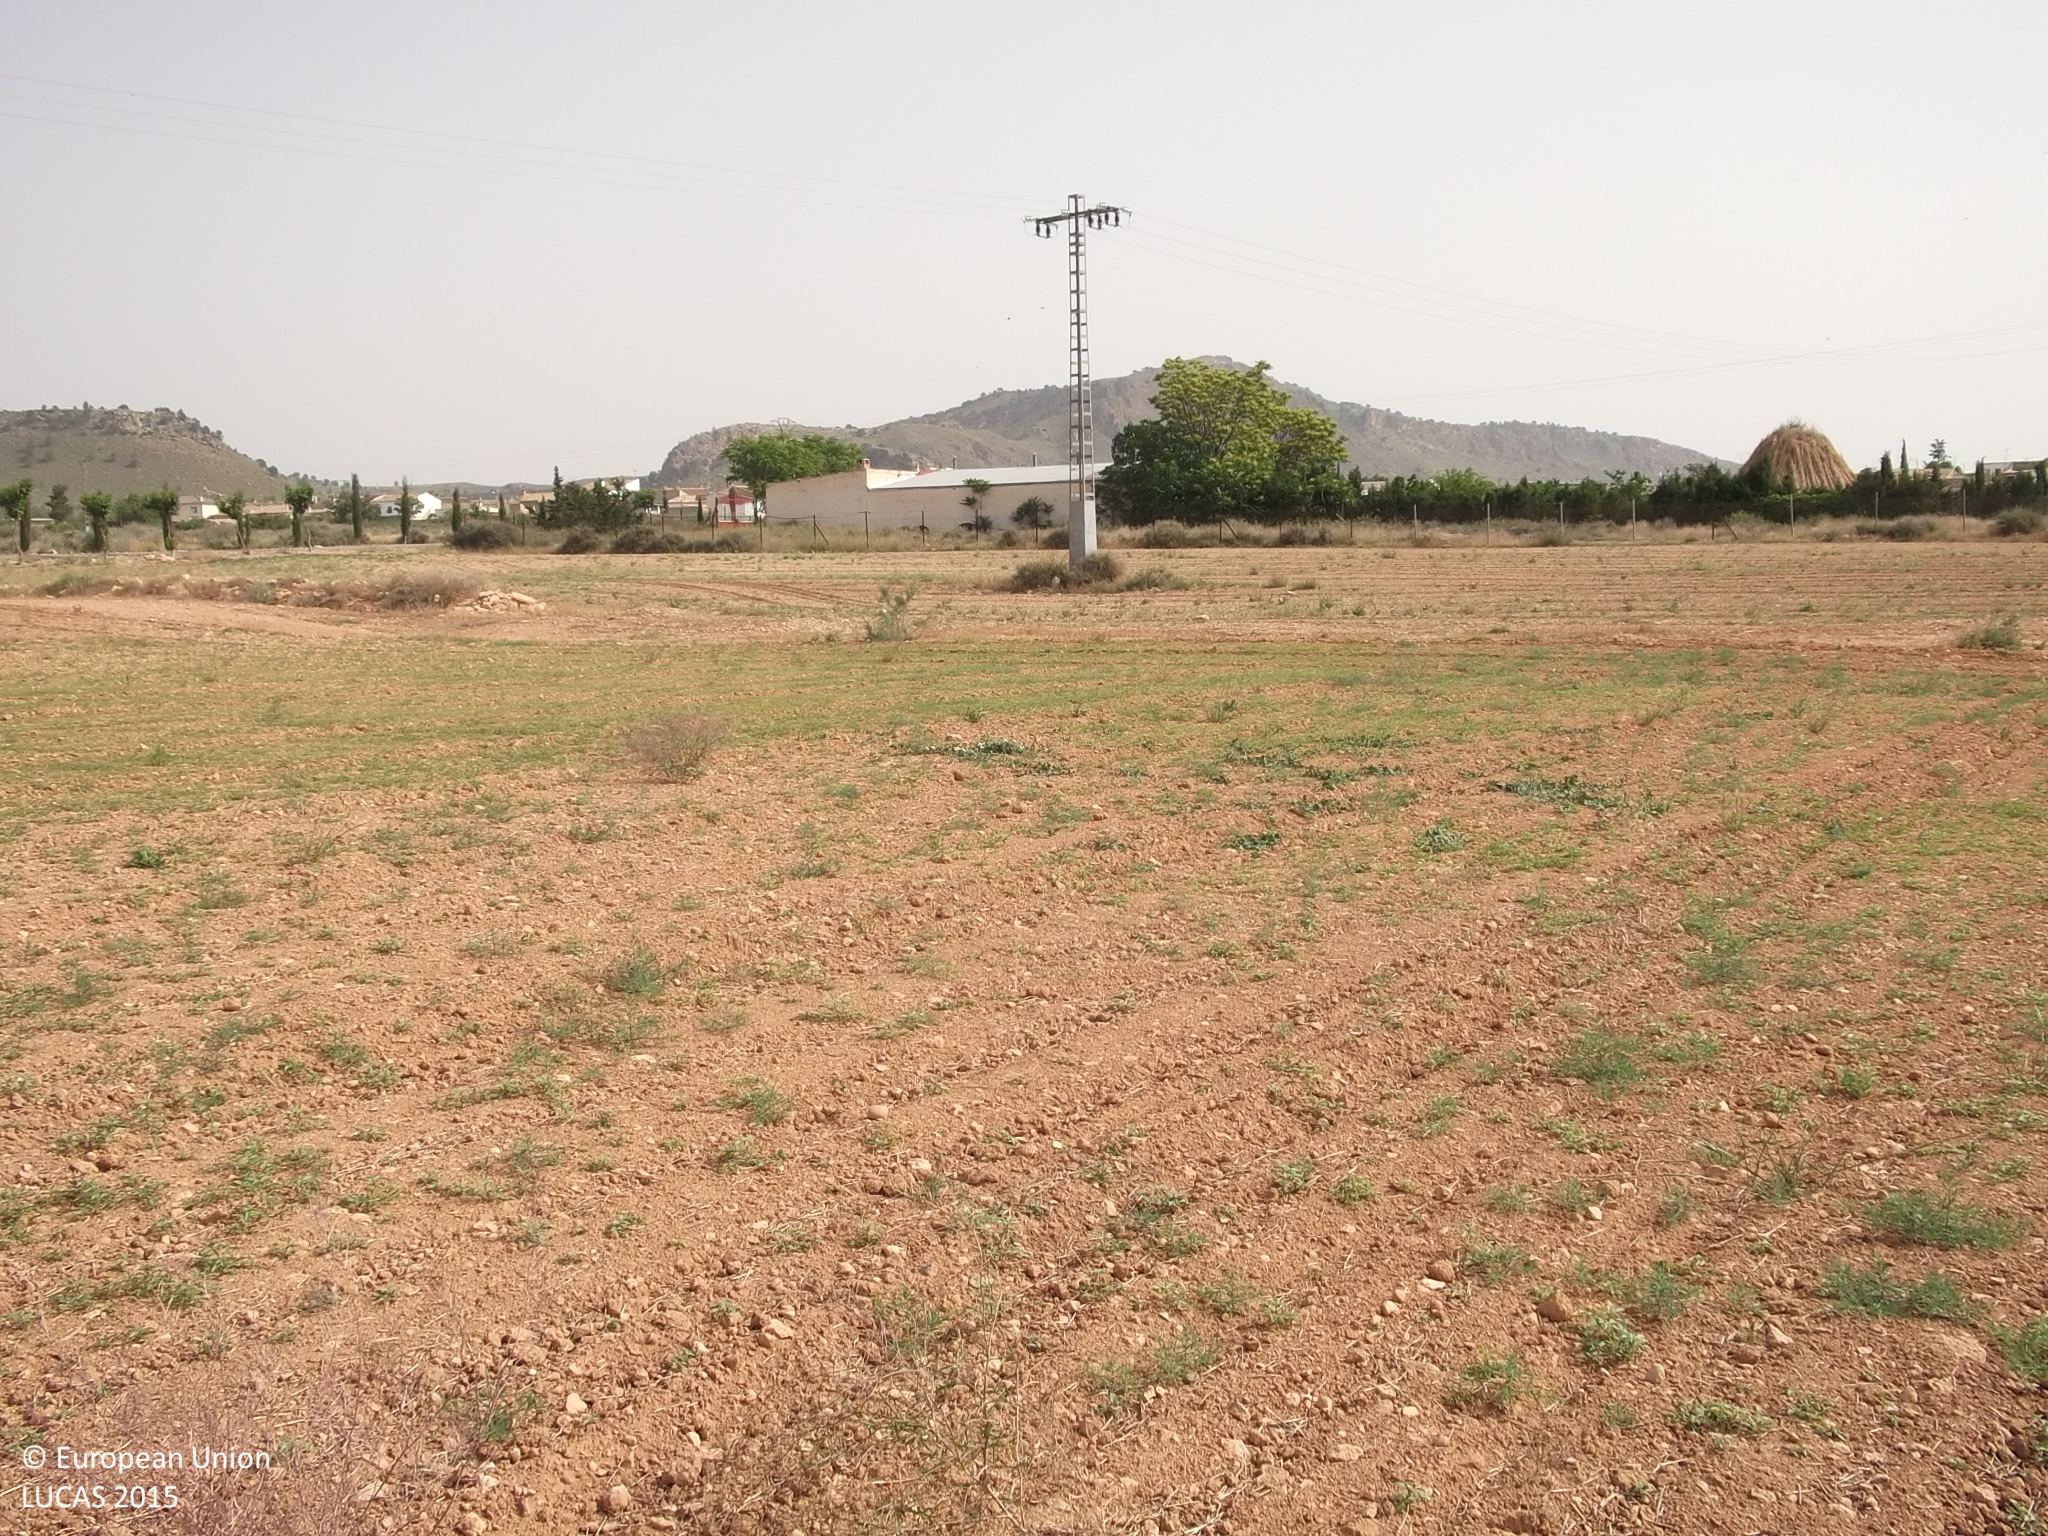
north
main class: Grassland
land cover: Spontaneously vegetated surfaces
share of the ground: 25 - 50 %
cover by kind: unconsolidated bare surface 70 %, herbaceous plants 30 %
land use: Fallow land
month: May
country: ES
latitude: 38.4206
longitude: -1.6404
